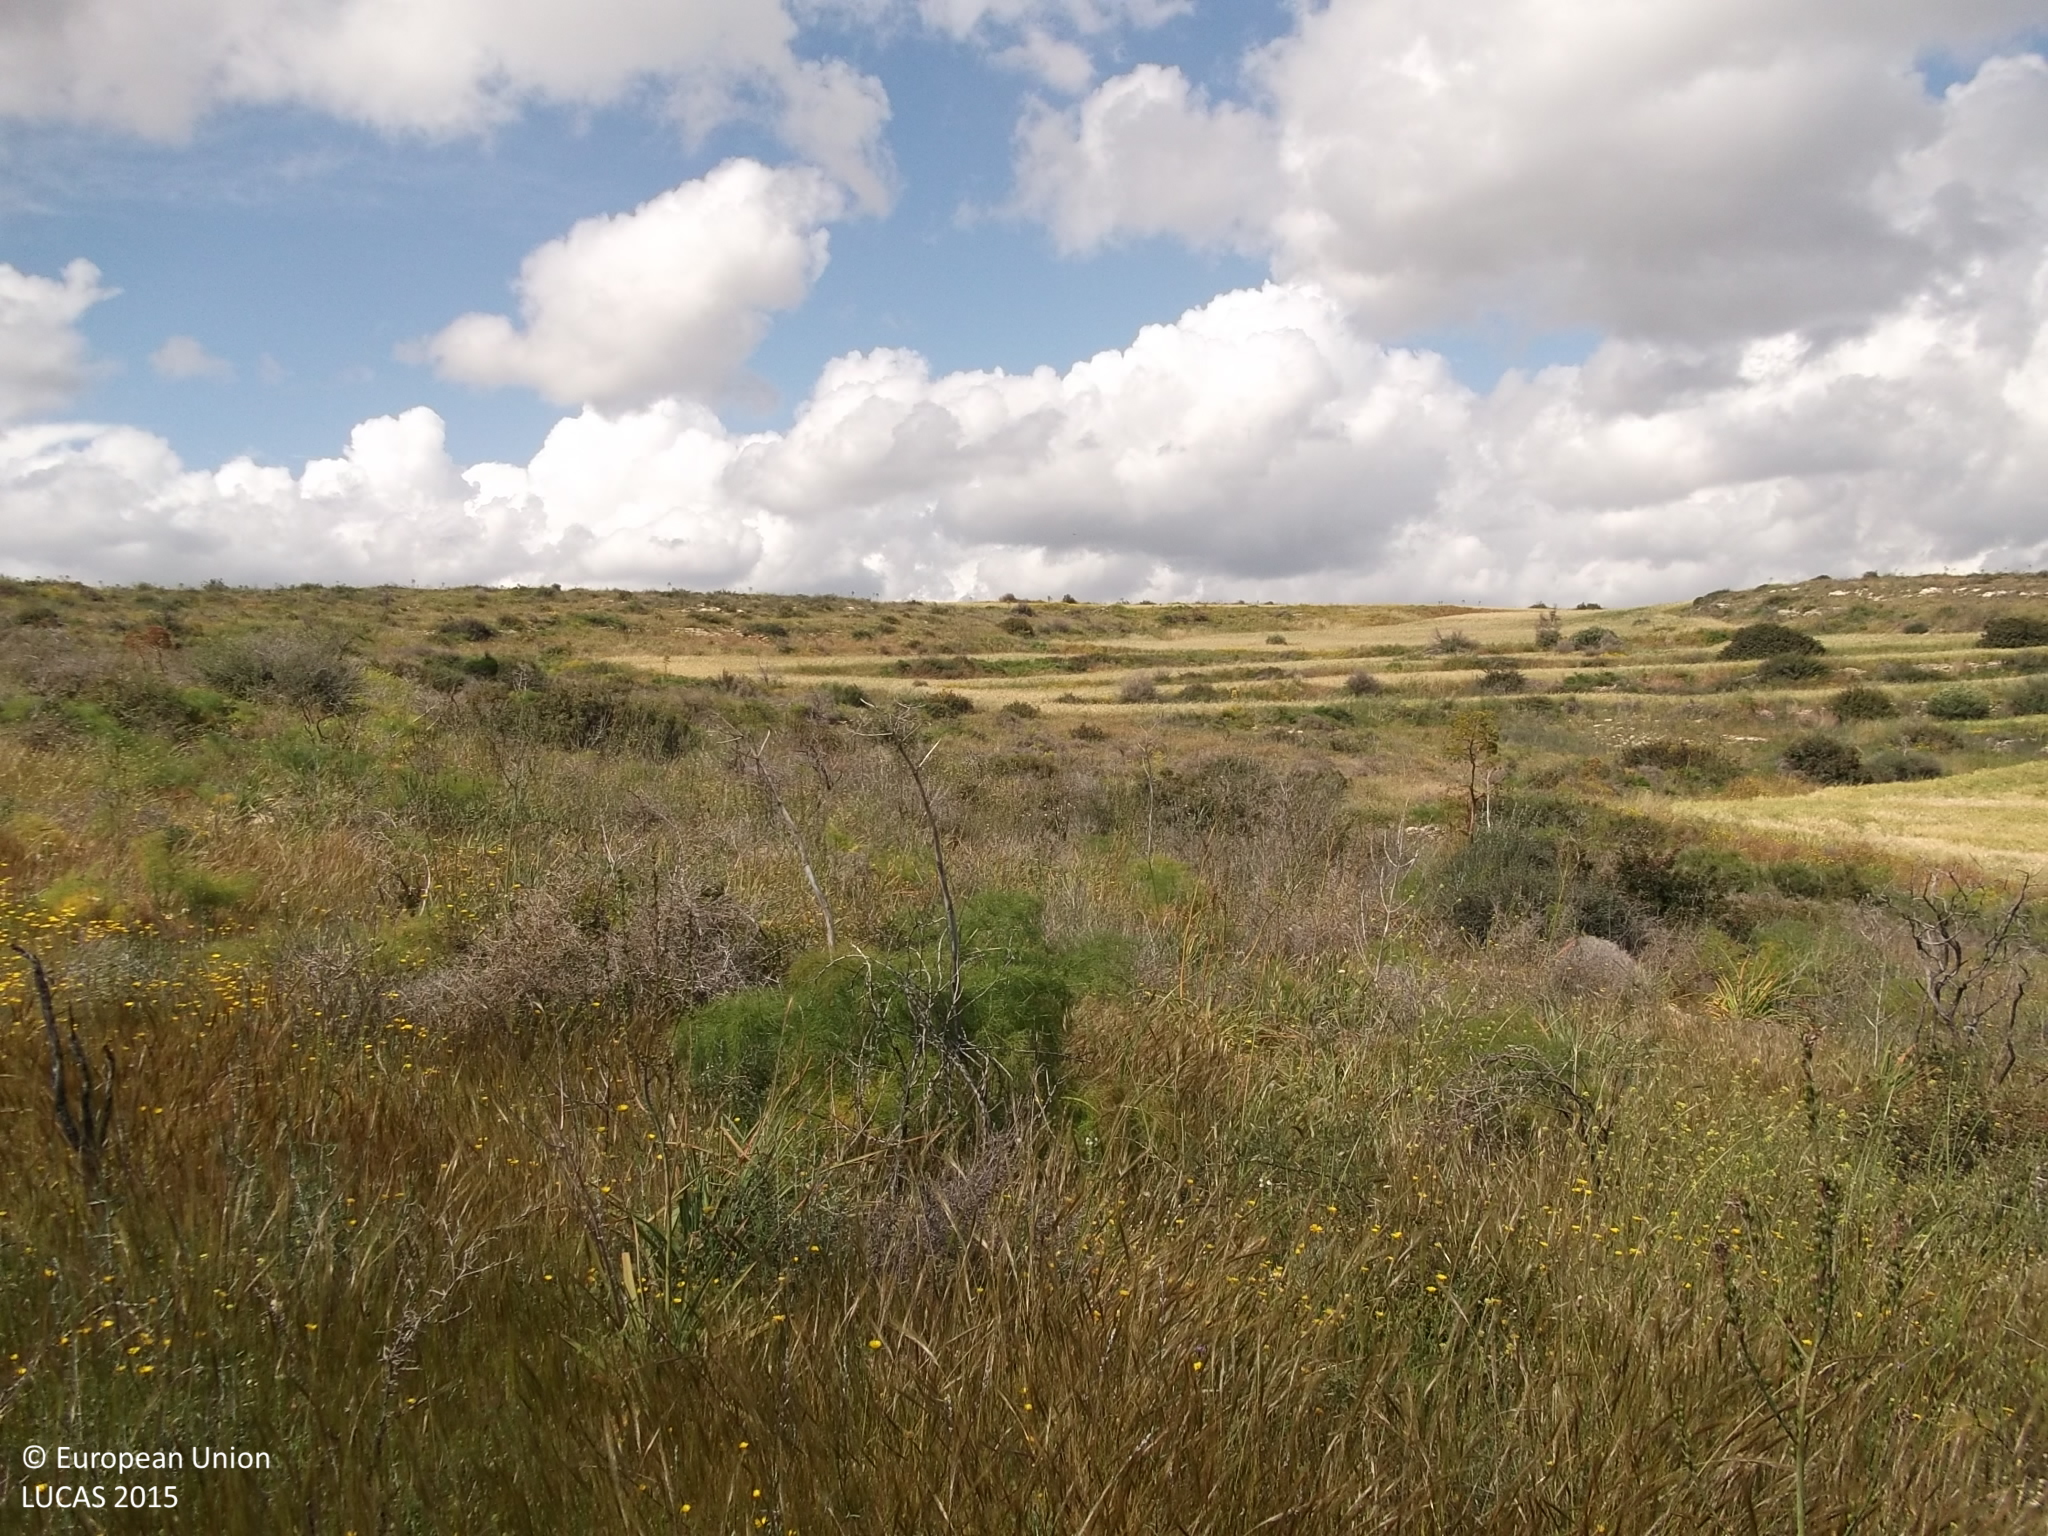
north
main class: Shrubland
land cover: Shrubland without tree cover
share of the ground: 50 - 75 %
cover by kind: shrubs 70 %, herbaceous plants 30 %
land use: Semi-natural and natural areas not in use
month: April
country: CY
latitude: 34.7779
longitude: 33.4256
